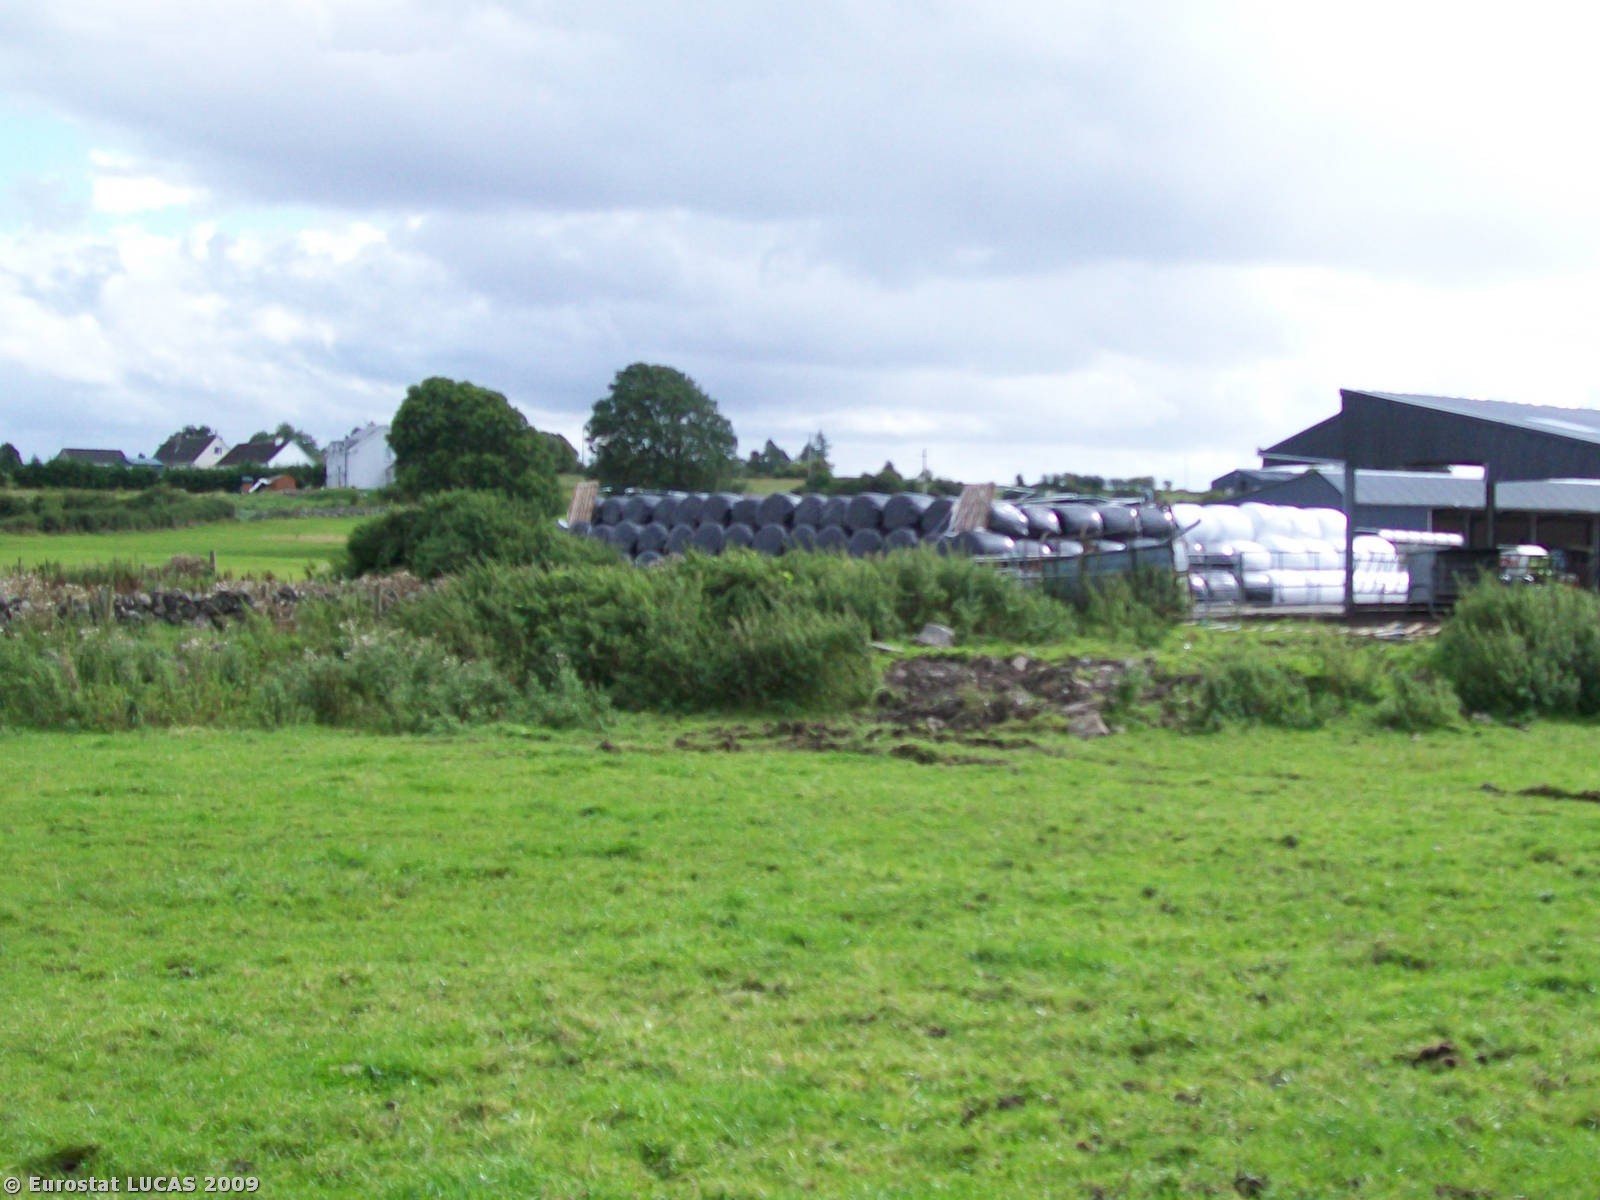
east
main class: Grassland
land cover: Grassland without tree/shrub cover
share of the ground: > 75 %
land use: Agriculture (excluding fallow land and kitchen gardens)
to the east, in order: Grassland without tree/shrub cover; Dry stone walls; Abandoned hedges; Grassland without tree/shrub cover; Broadleaved woodland; Dry stone walls; Grassland without tree/shrub cover; Dry stone walls; Grassland without tree/shrub cover
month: August
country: IE
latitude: 53.1200
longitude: -8.7461
